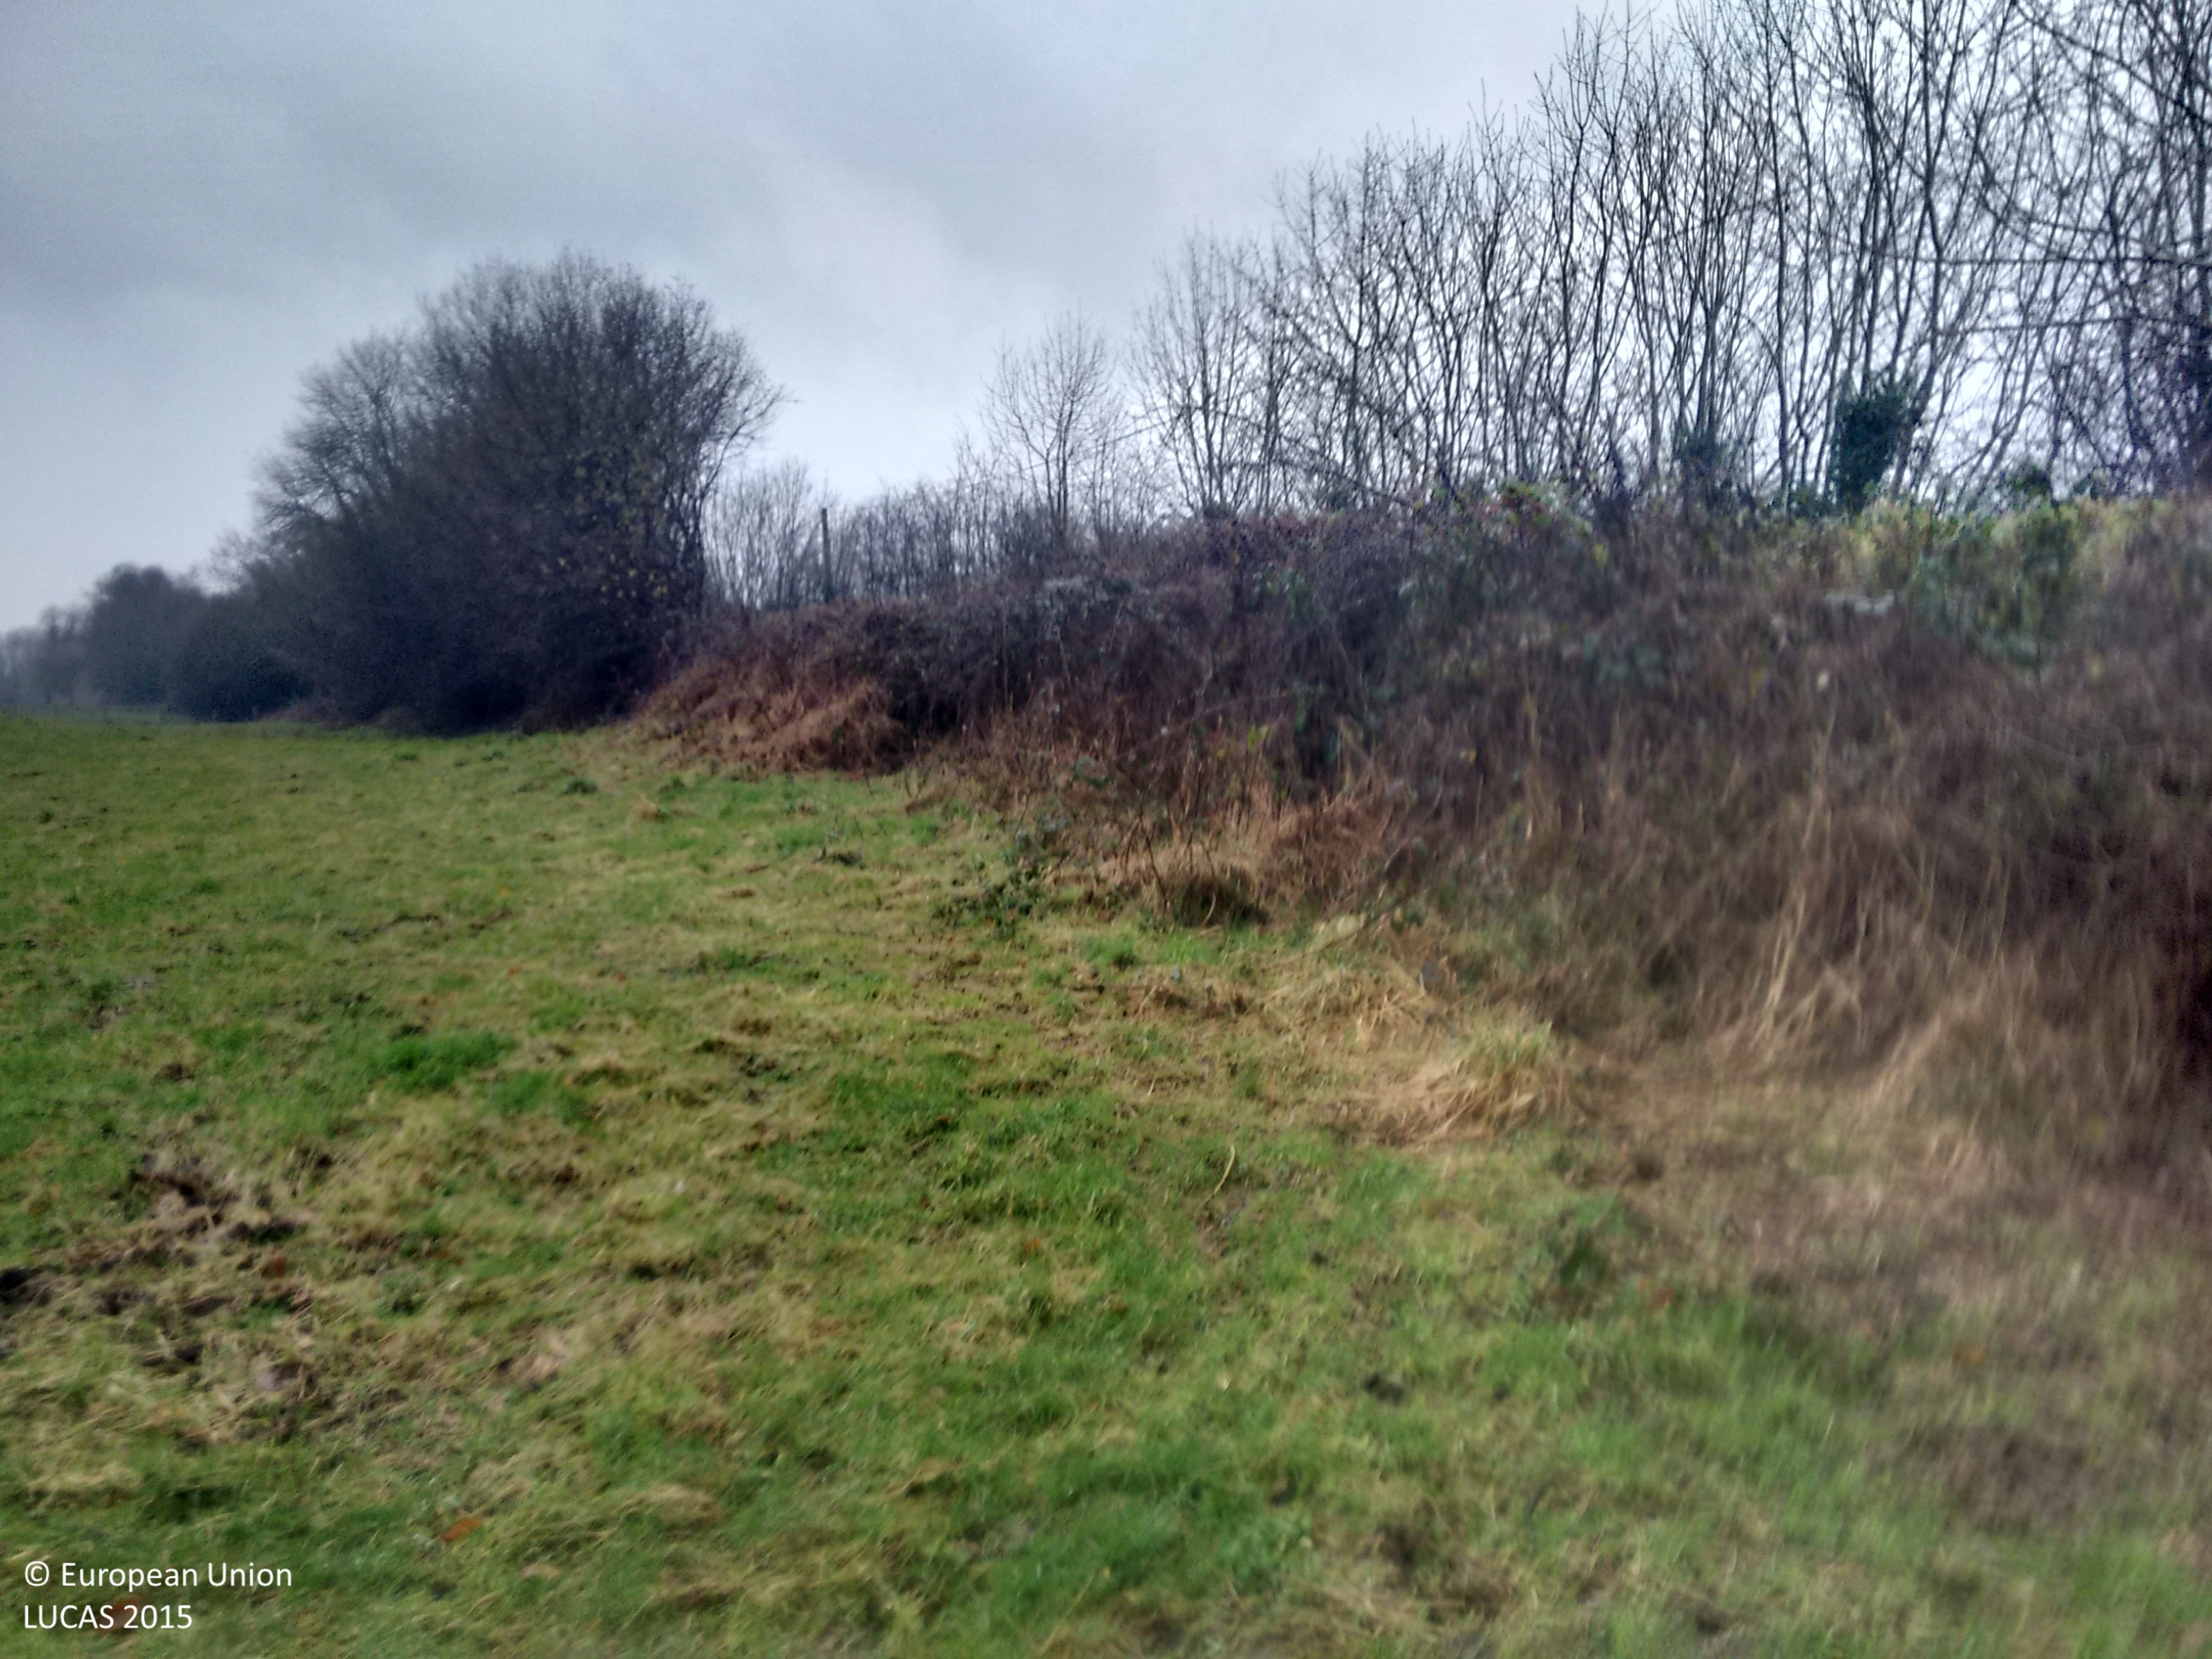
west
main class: Grassland
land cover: Grassland without tree/shrub cover
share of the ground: > 75 %
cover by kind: herbaceous plants 95 %, unconsolidated bare surface 5 %
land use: Agriculture (excluding fallow land and kitchen gardens)
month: December
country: IE
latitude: 54.1703
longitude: -7.2909
